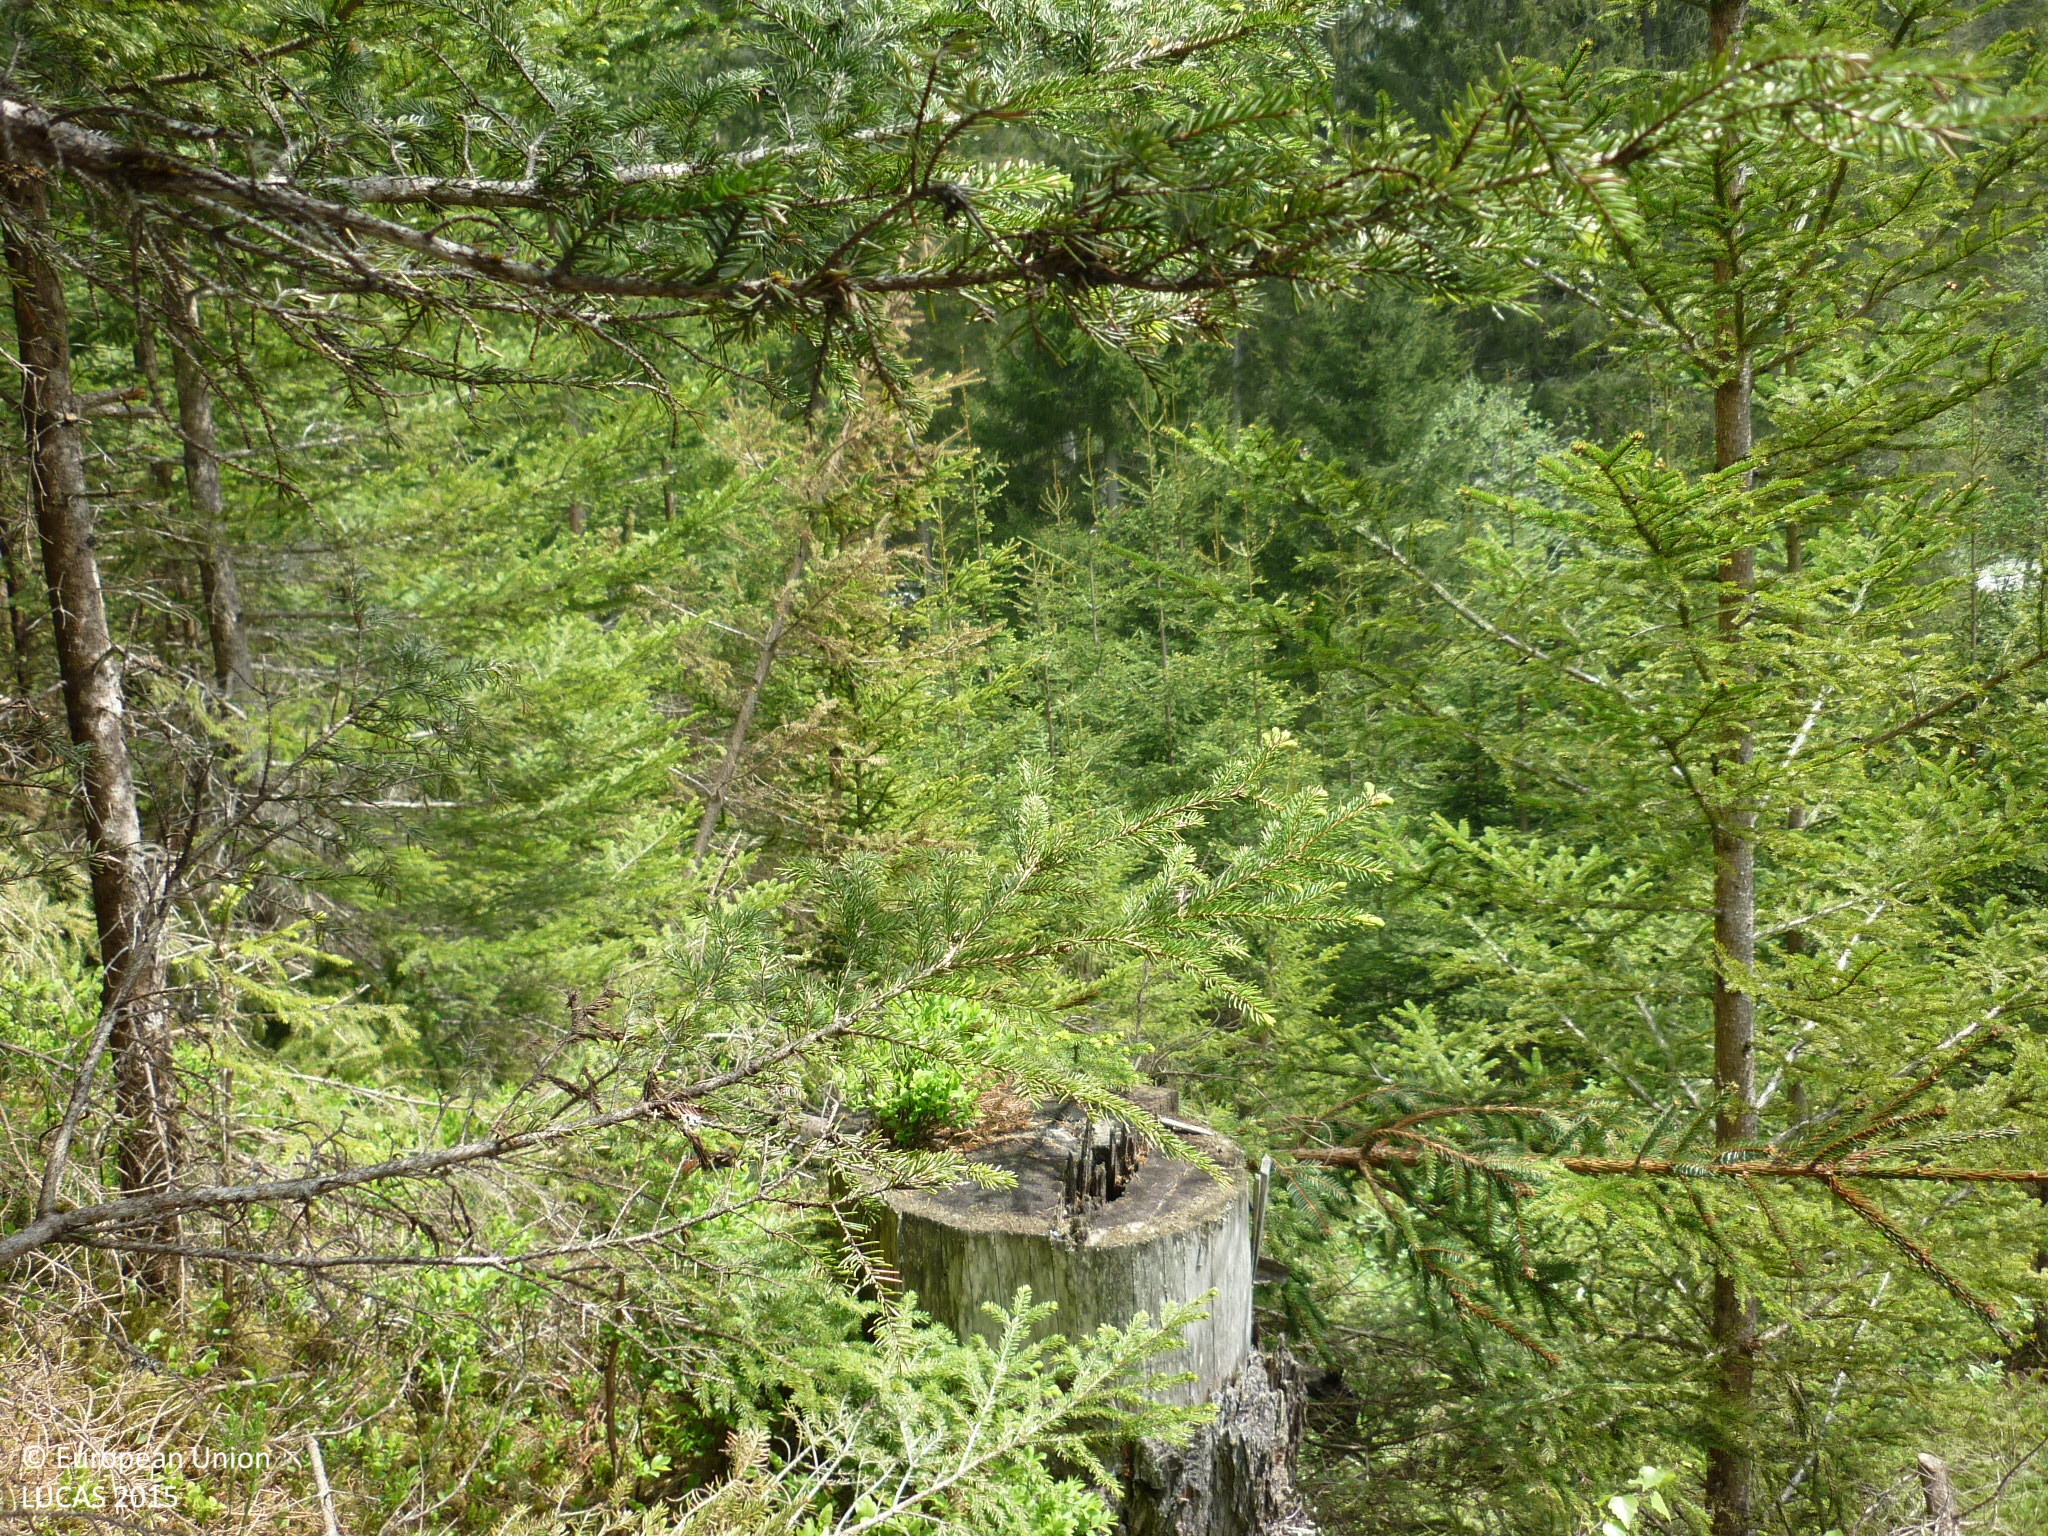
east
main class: Woodland
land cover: Spruce dominated coniferous woodland
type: alpine coniferous forest
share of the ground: > 75 %
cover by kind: coniferous forest trees 75 %, broadleaved forest trees 20 %, herbaceous plants 5 %
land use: Forestry
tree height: > 5 m
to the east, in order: Spruce dominated coniferous woodland; Inland fresh running water; Spruce dominated coniferous woodland; Shrubland with sparse tree cover; Inland fresh running water; Spruce dominated mixed woodland; Inland fresh running water; Spruce dominated mixed woodland; Shrubland with sparse tree cover
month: May
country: AT
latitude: 47.4287
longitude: 14.0421
